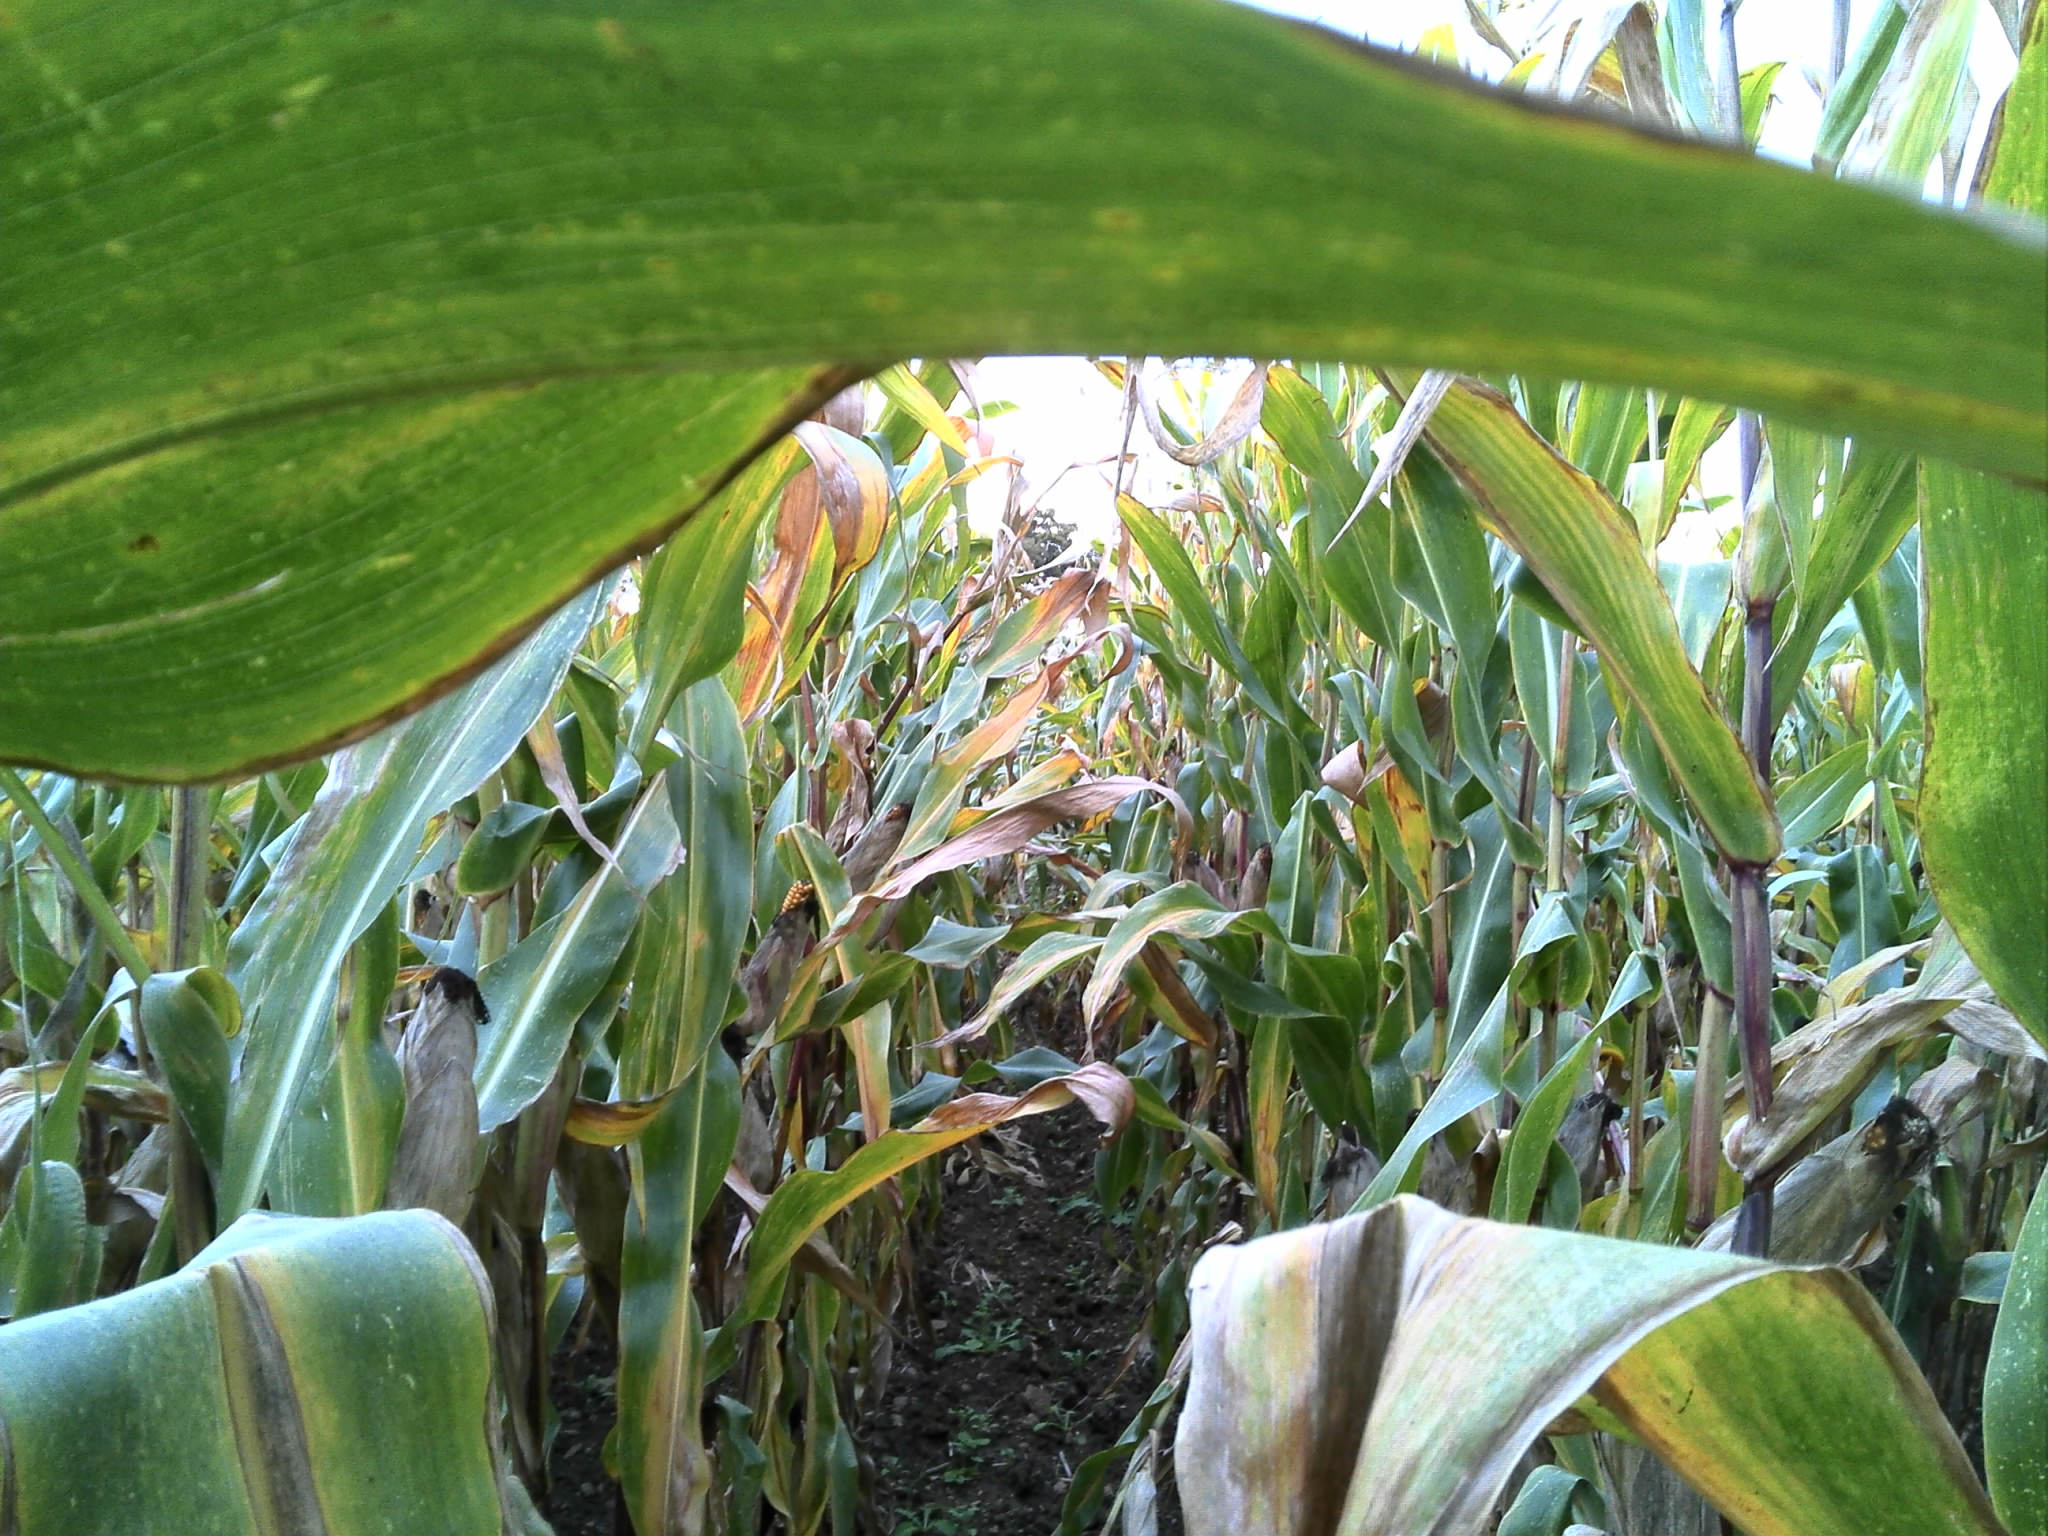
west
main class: Cropland
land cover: Maize
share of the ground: > 75 %
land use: Agriculture (excluding fallow land and kitchen gardens)
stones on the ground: 10 - 25 %
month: October
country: FR
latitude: 47.9059
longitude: -0.0755
